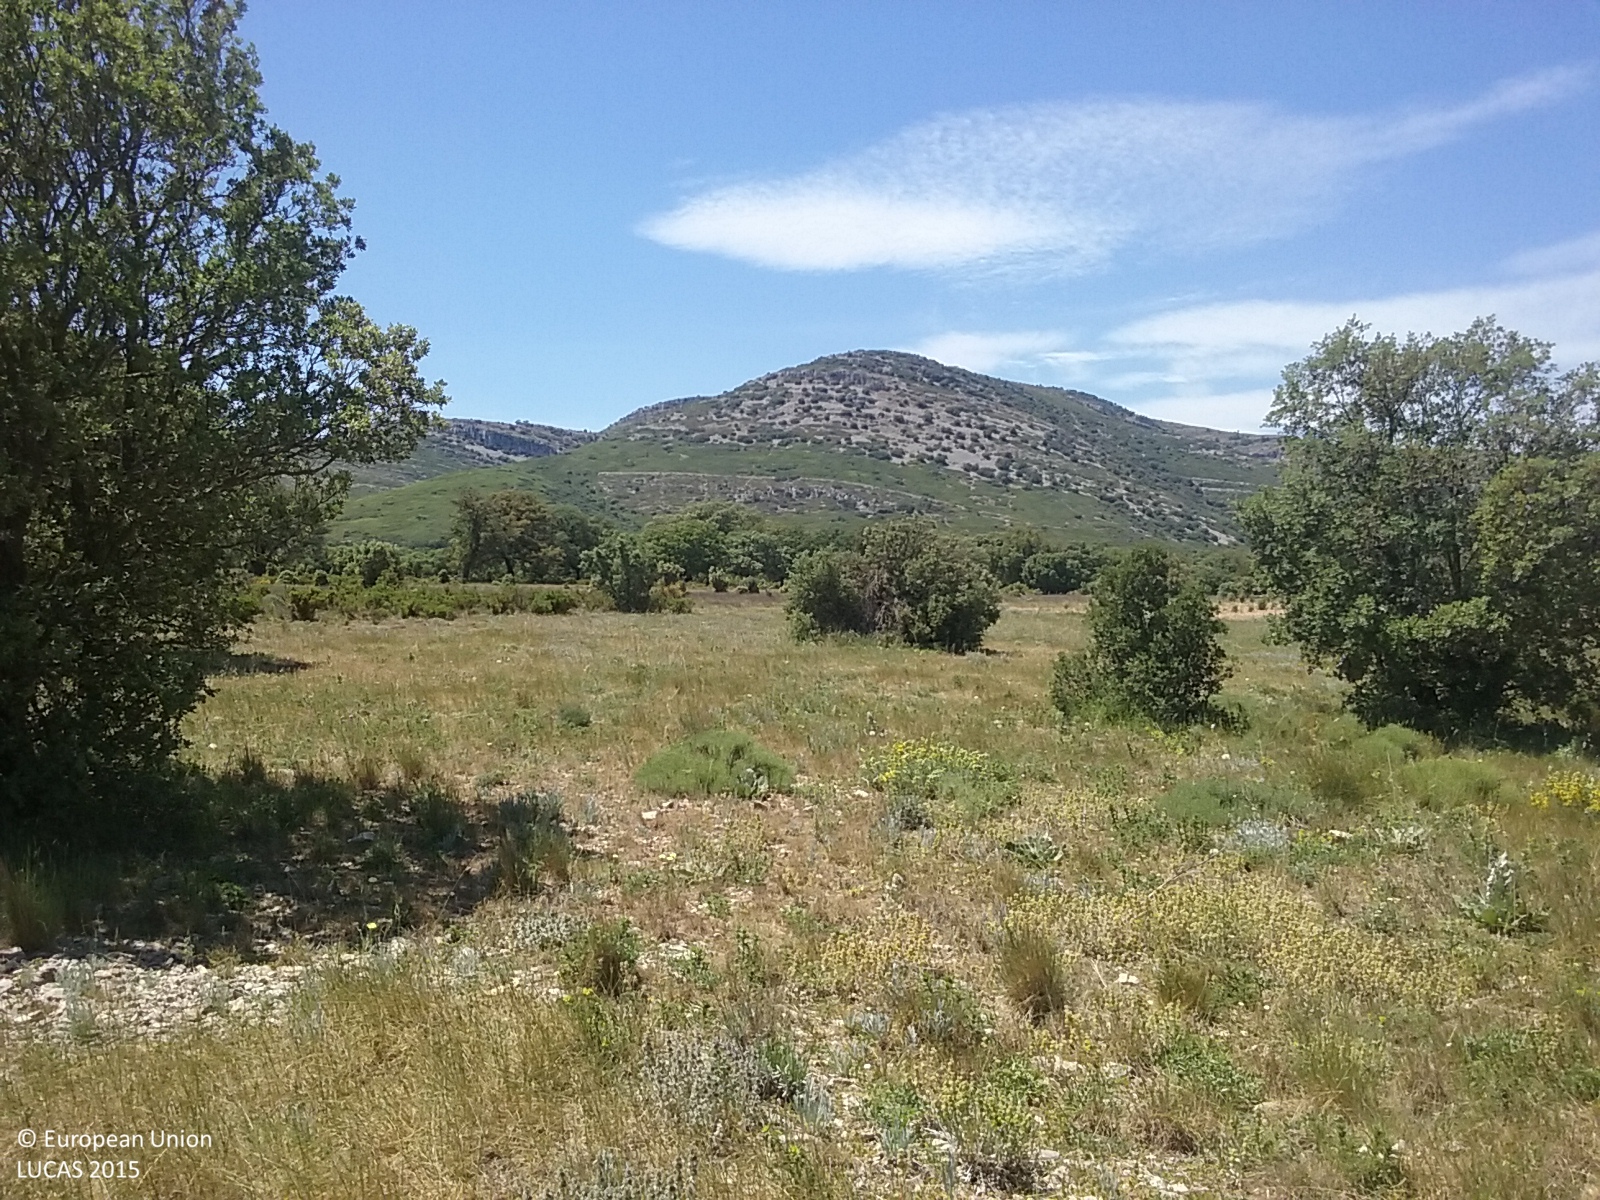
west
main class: Woodland
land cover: Broadleaved woodland
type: broadleaved evergreen forest
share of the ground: 10 - 25 %
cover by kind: herbaceous plants 80 %, broadleaved forest trees 20 %
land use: Forestry
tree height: < 5 m
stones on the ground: 25 - 50 %
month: May
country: ES
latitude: 40.4076
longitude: -0.0328
